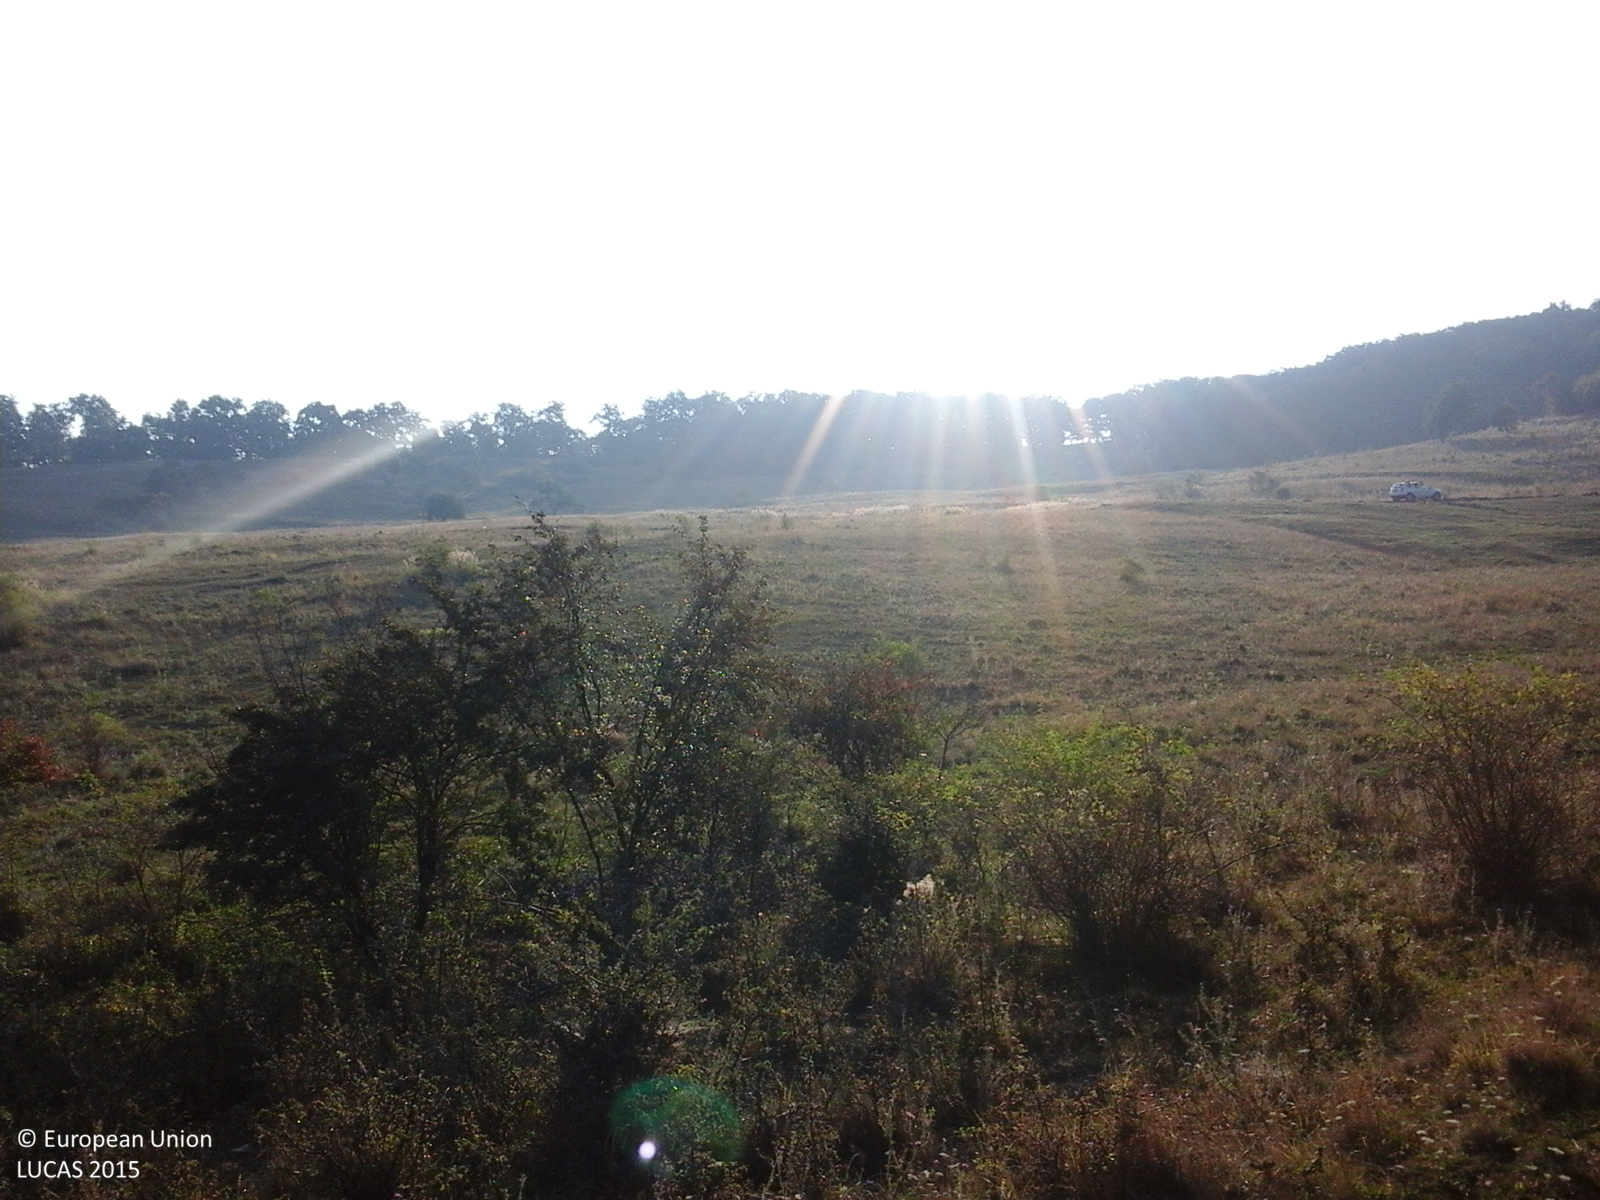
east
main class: Grassland
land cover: Grassland with sparse tree/shrub cover
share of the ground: > 75 %
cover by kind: herbaceous plants 95 %, broadleaved forest trees 5 %
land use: Fallow land
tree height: < 5 m
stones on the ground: < 10 %
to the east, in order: Grassland with sparse tree/shrub cover; Abandoned hedges; Grassland without tree/shrub cover; Tracks; Grassland without tree/shrub cover; Grassland with sparse tree/shrub cover
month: September
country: RO
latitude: 47.0529
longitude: 24.5322
